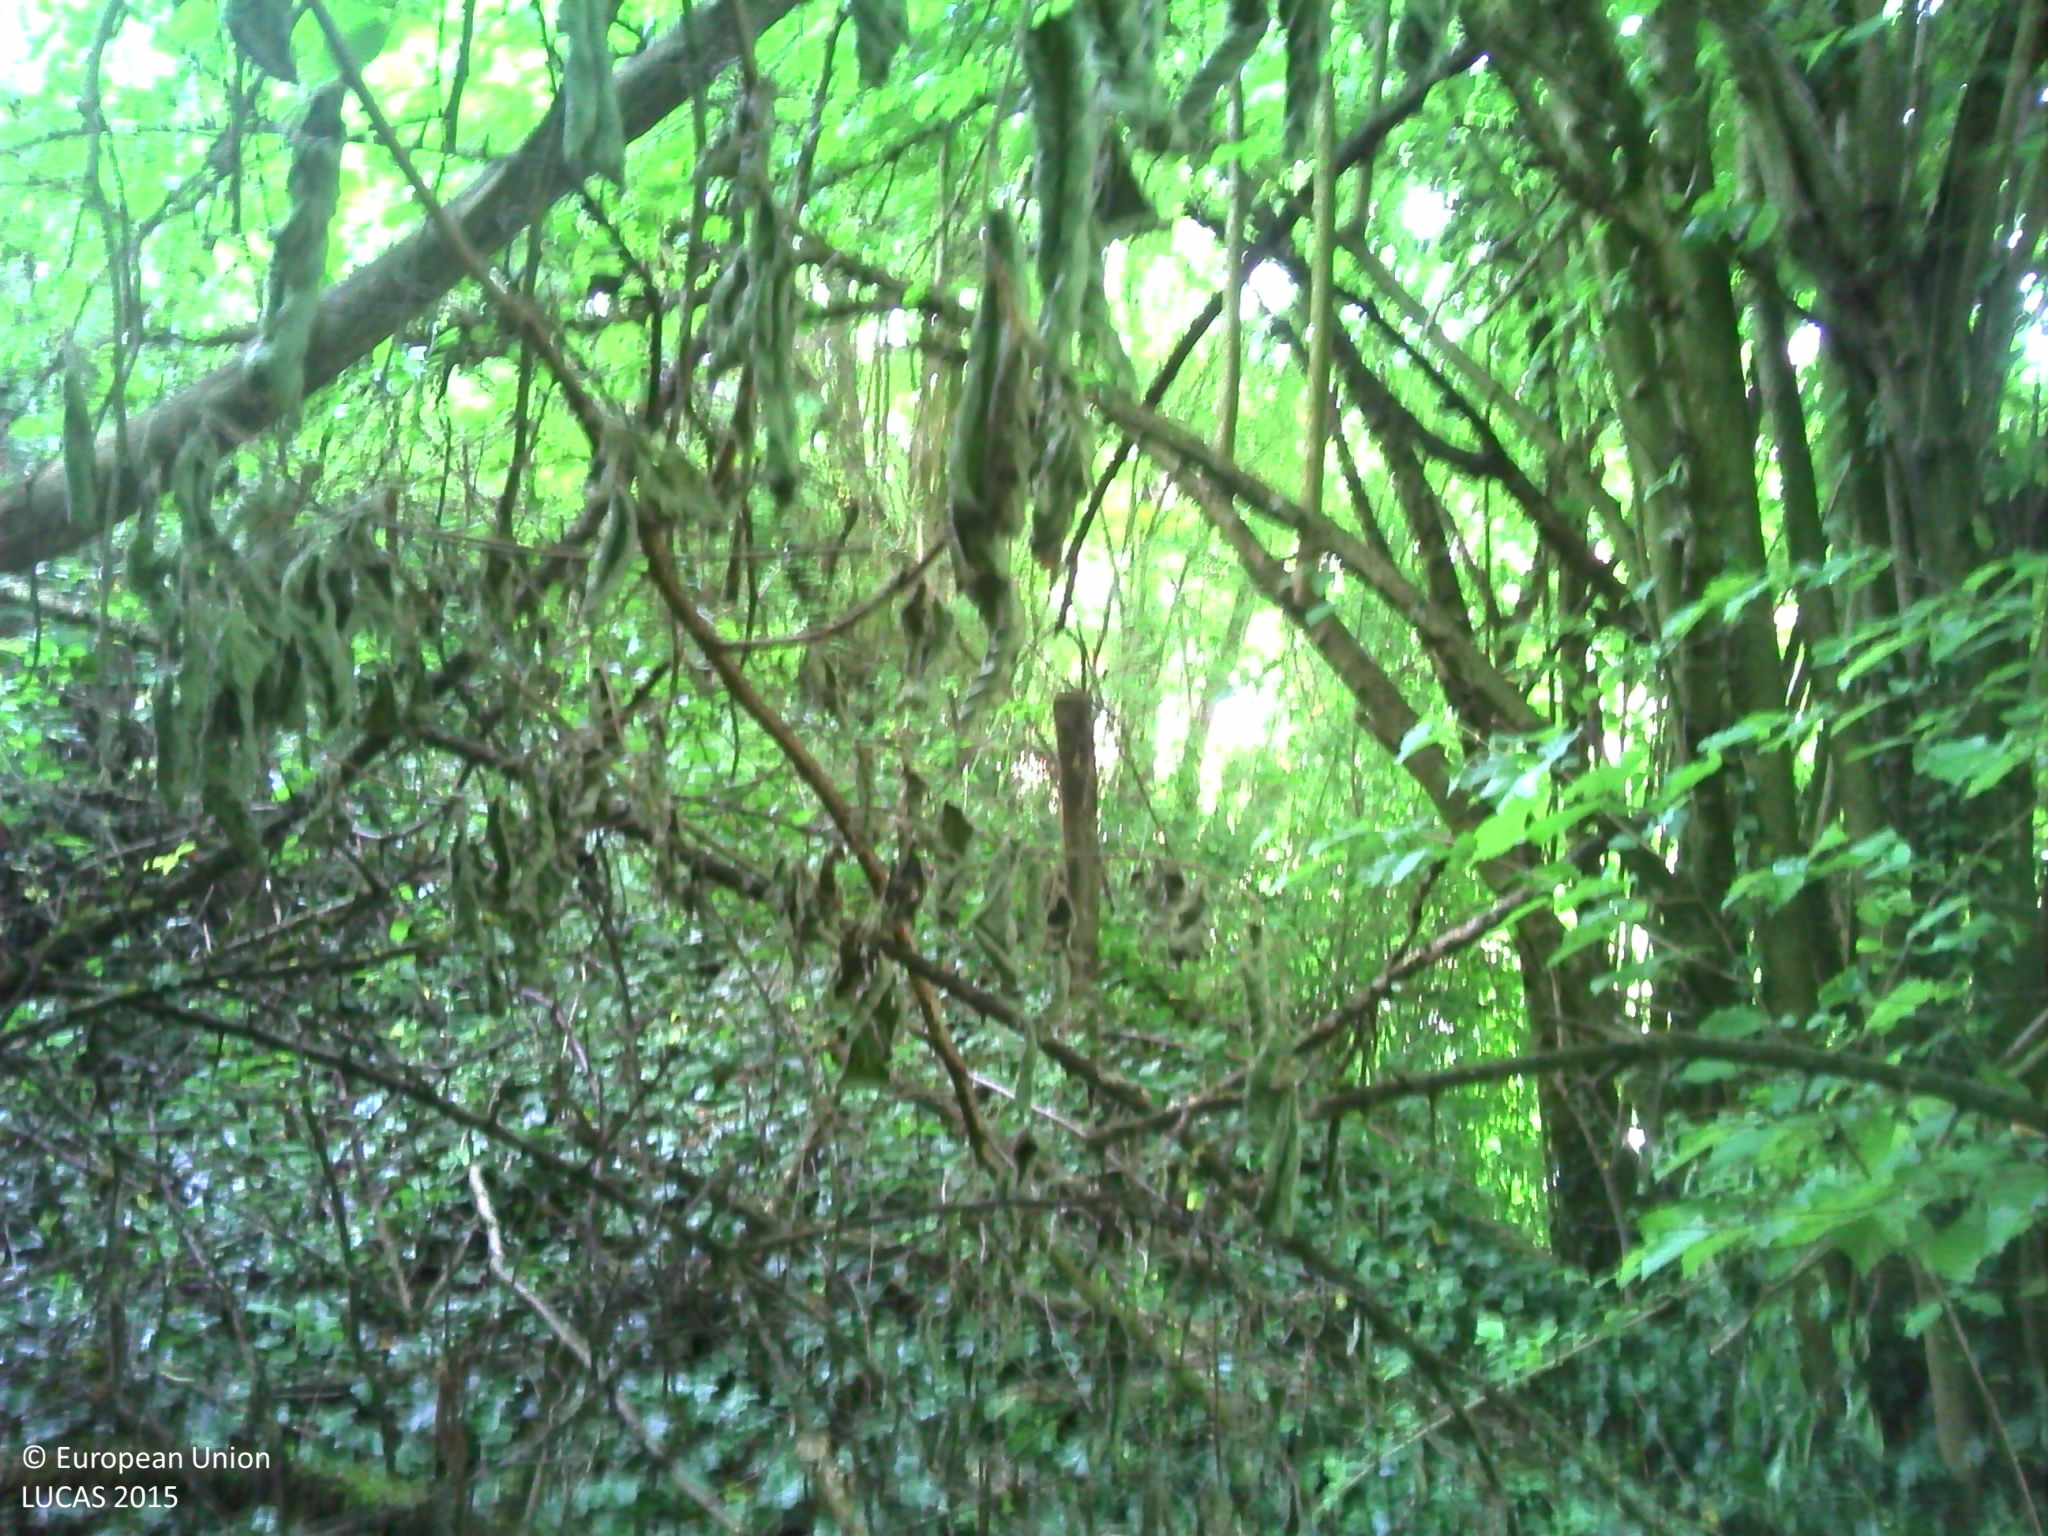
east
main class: Woodland
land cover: Broadleaved woodland
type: mesophytic deciduous forest
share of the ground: > 75 %
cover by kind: broadleaved forest trees 100 %
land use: Forestry
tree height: > 5 m
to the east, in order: Broadleaved woodland; Fences; Broadleaved woodland; Artificial constructions in urban areas
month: June
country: FR
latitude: 47.4903
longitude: 7.3870
